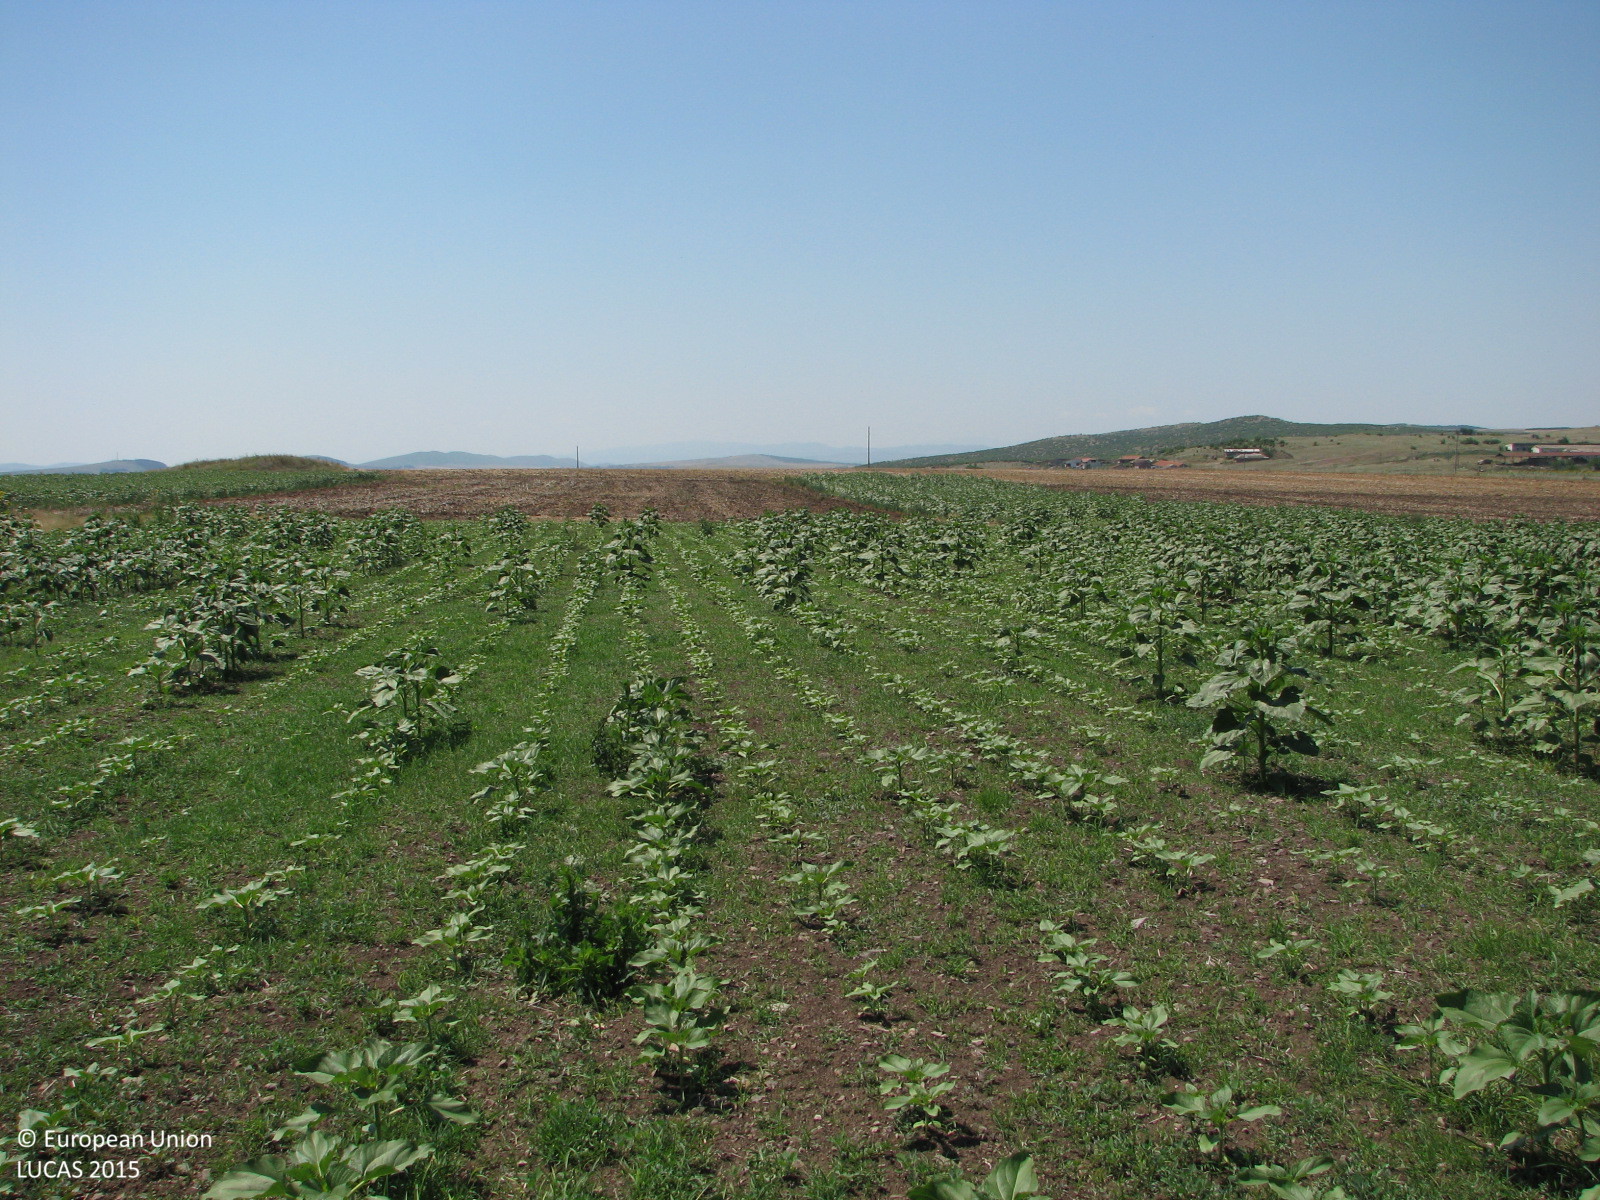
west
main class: Cropland
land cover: Sunflower
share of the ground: 10 - 25 %
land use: Agriculture (excluding fallow land and kitchen gardens)
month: July
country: BG
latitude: 42.5083
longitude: 26.3606
